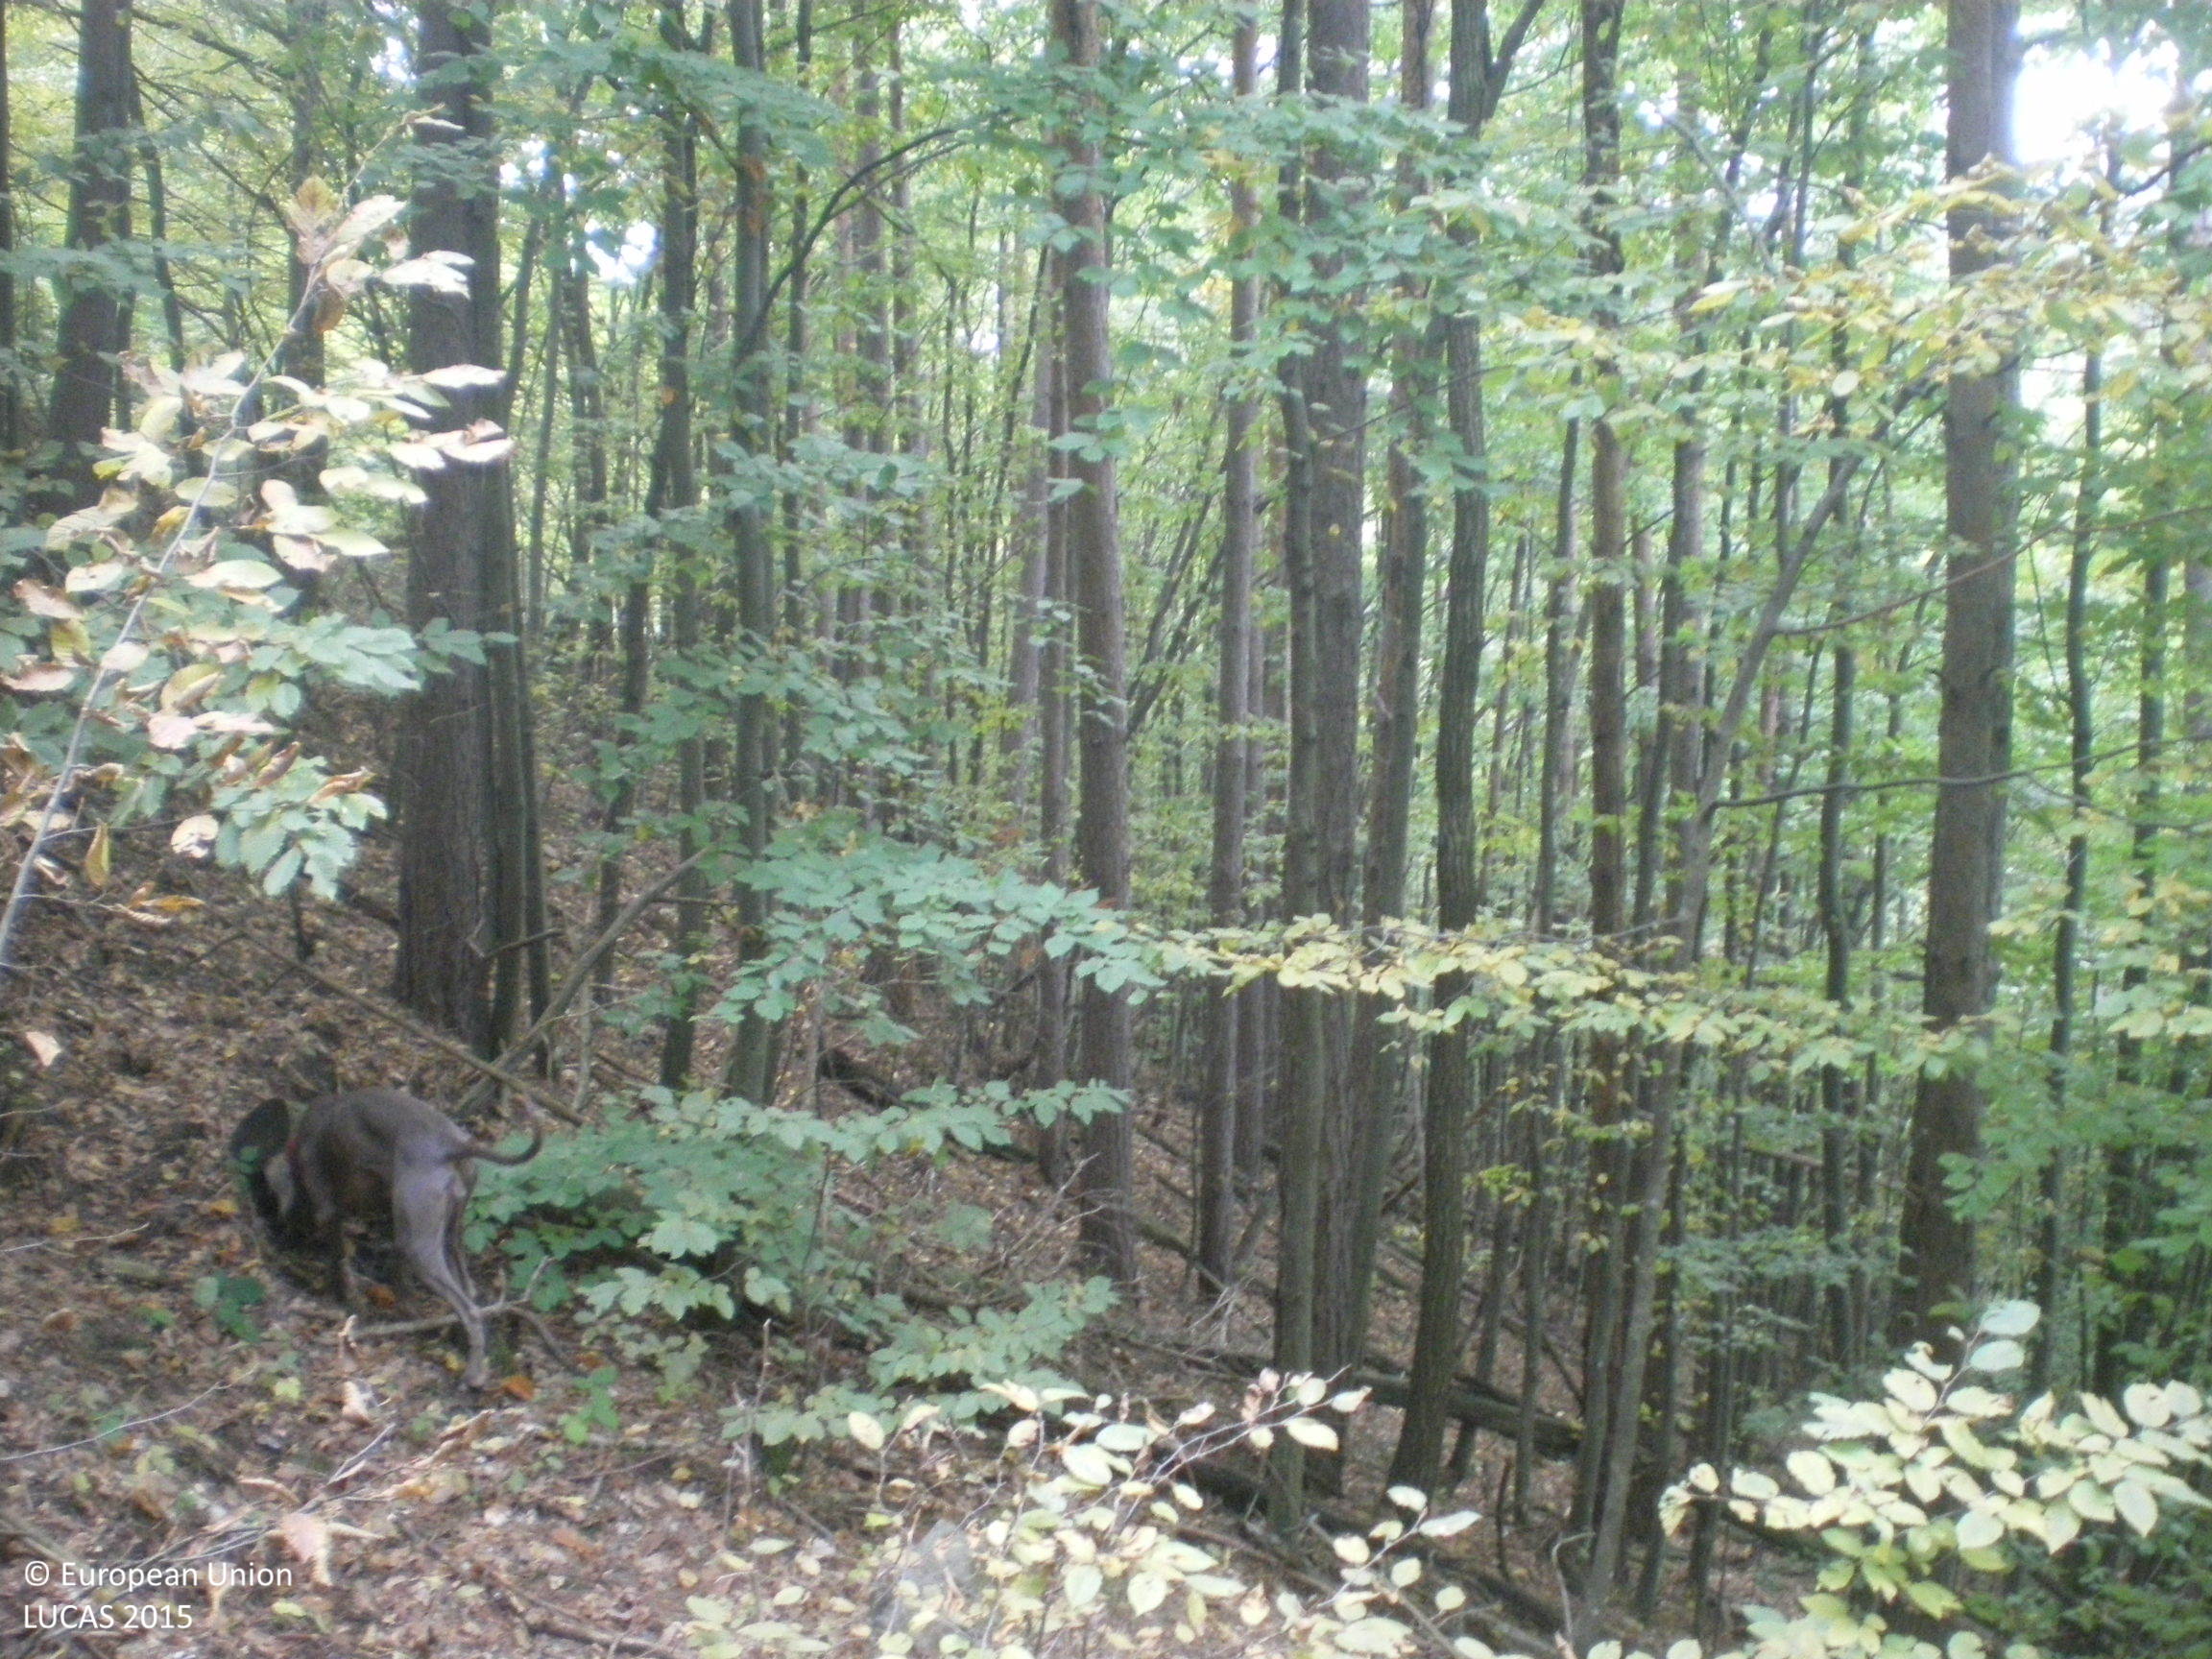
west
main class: Woodland
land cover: Pine dominated mixed woodland
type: hemiboreal forest and nemoral coniferous forest and mixed broadleaved-coniferous forest
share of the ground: > 75 %
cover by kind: coniferous forest trees 60 %, broadleaved forest trees 25 %, shrubs 15 %
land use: Forestry
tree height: > 5 m
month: October
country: BG
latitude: 42.7287
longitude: 25.6726
